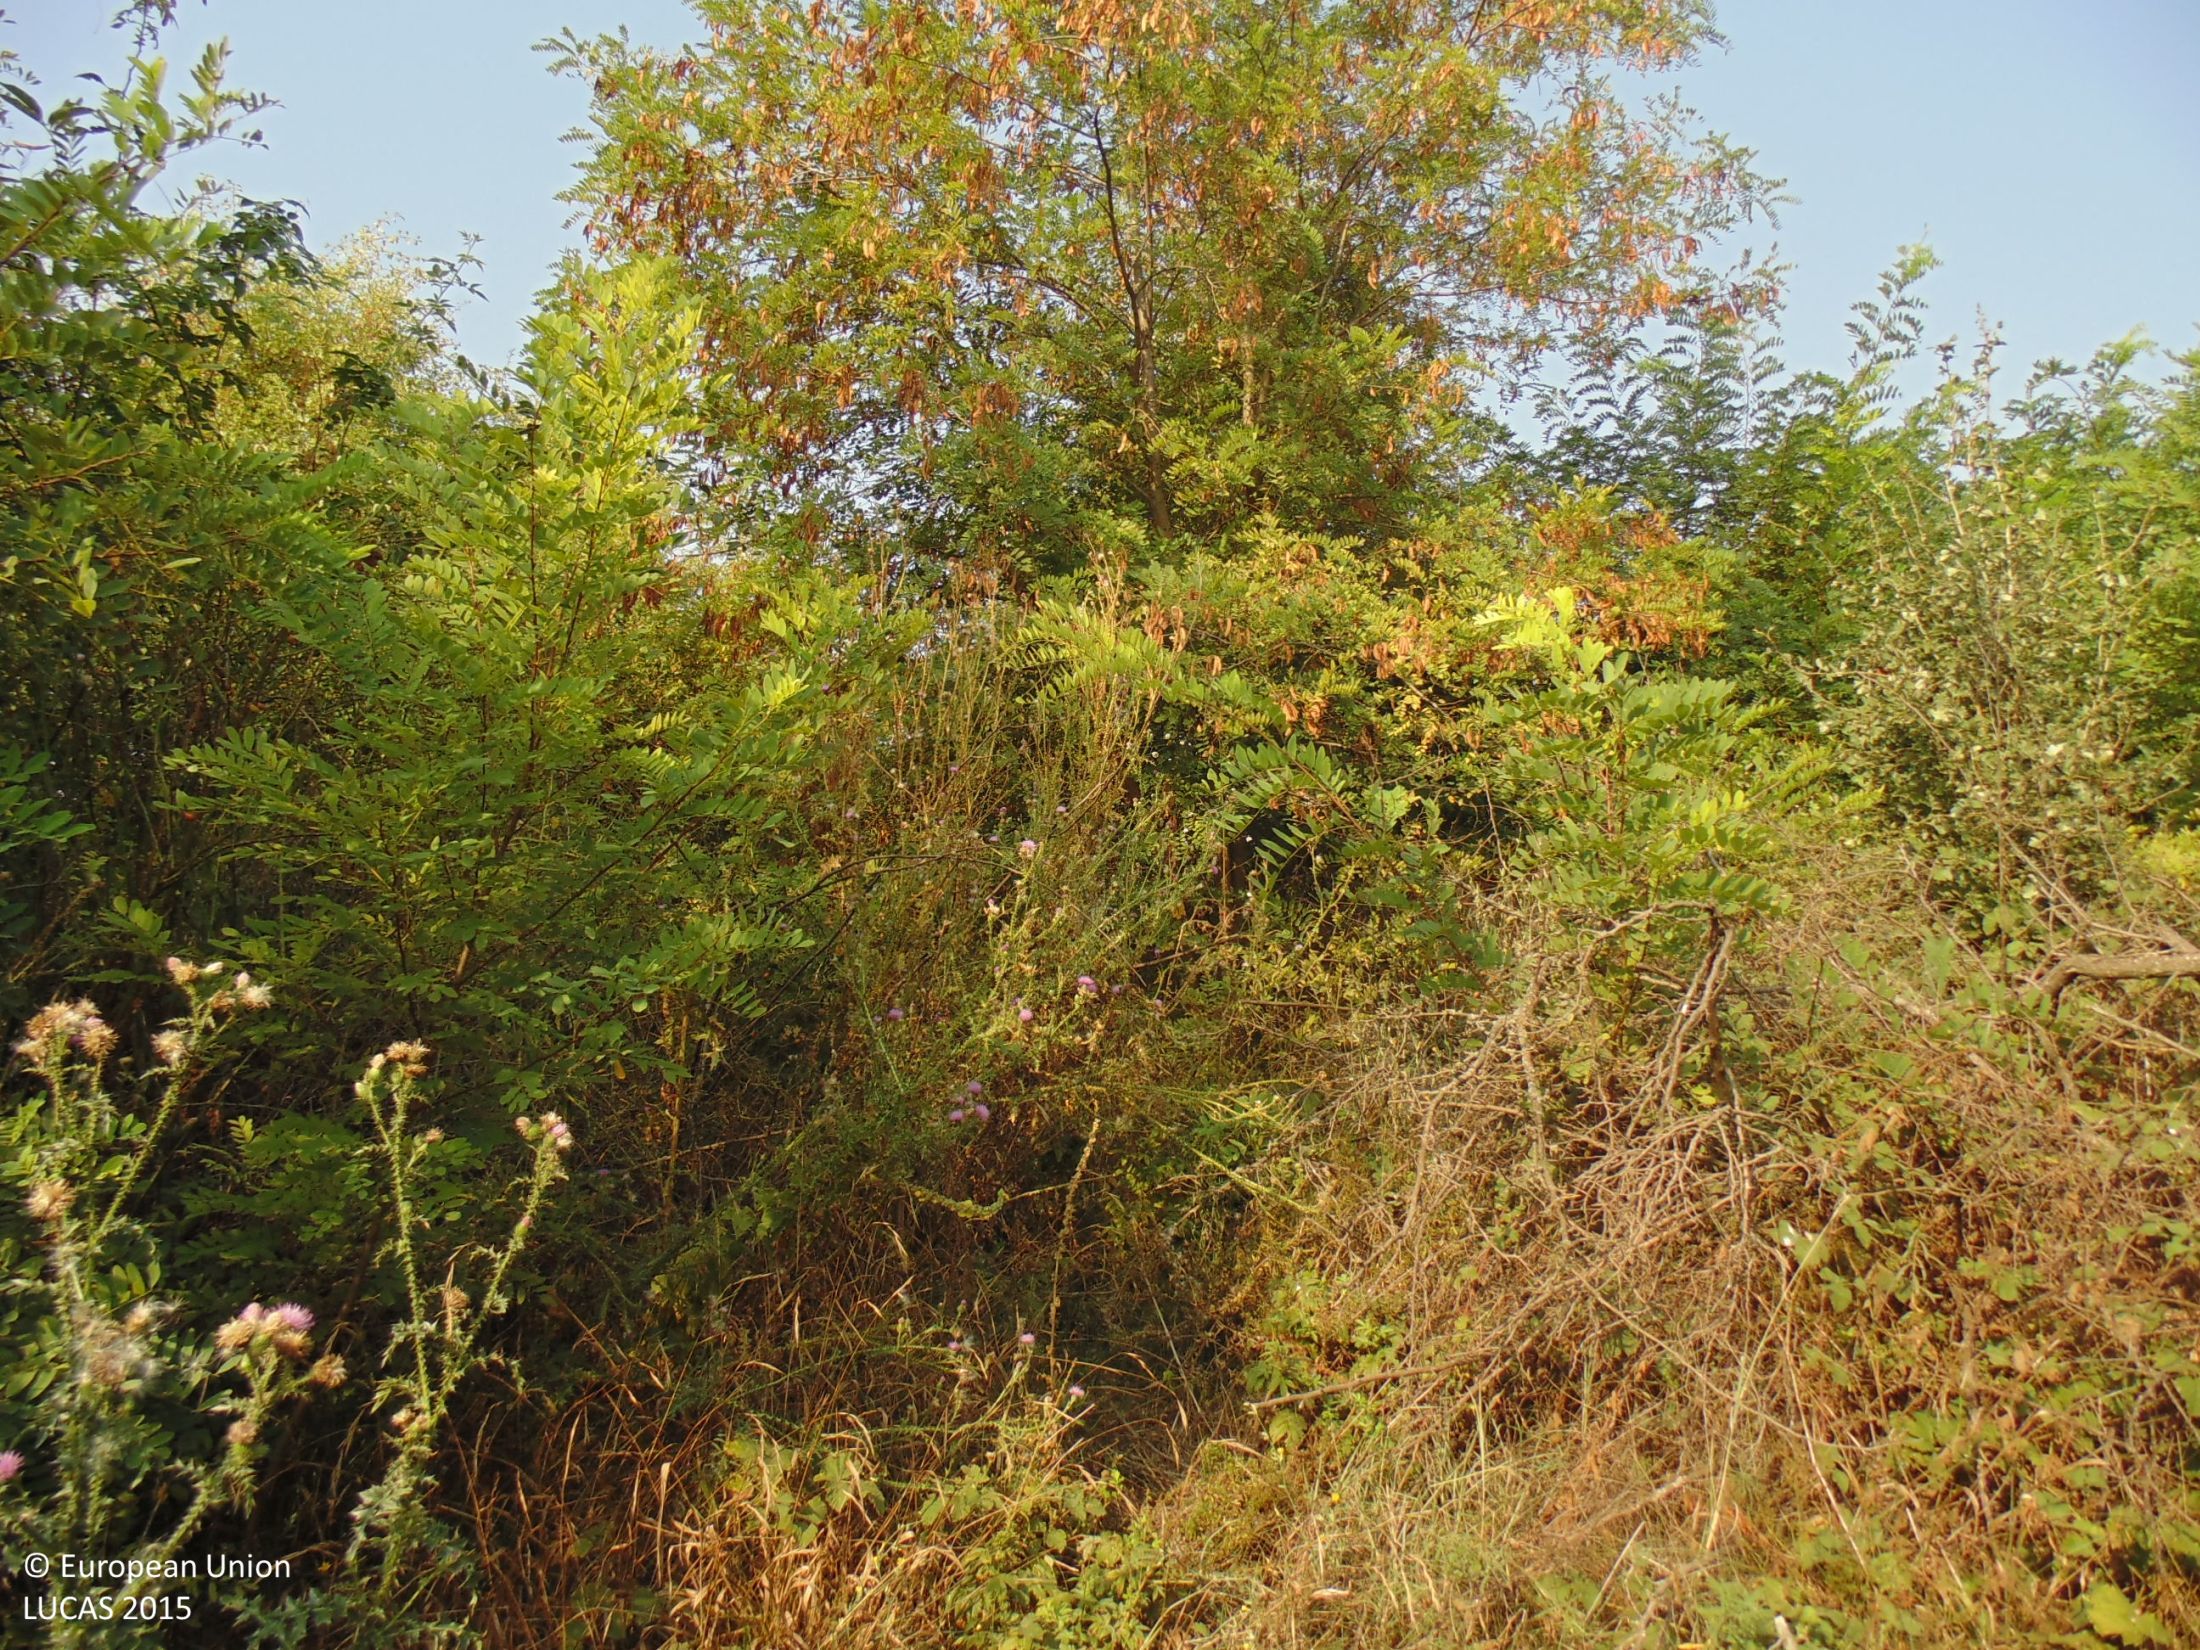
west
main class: Woodland
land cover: Broadleaved woodland
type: mesophytic deciduous forest
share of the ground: > 75 %
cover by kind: broadleaved forest trees 85 %, unconsolidated bare surface 10 %, shrubs 5 %
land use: Forestry
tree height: > 5 m
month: August
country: BG
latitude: 44.0112
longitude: 27.3845
